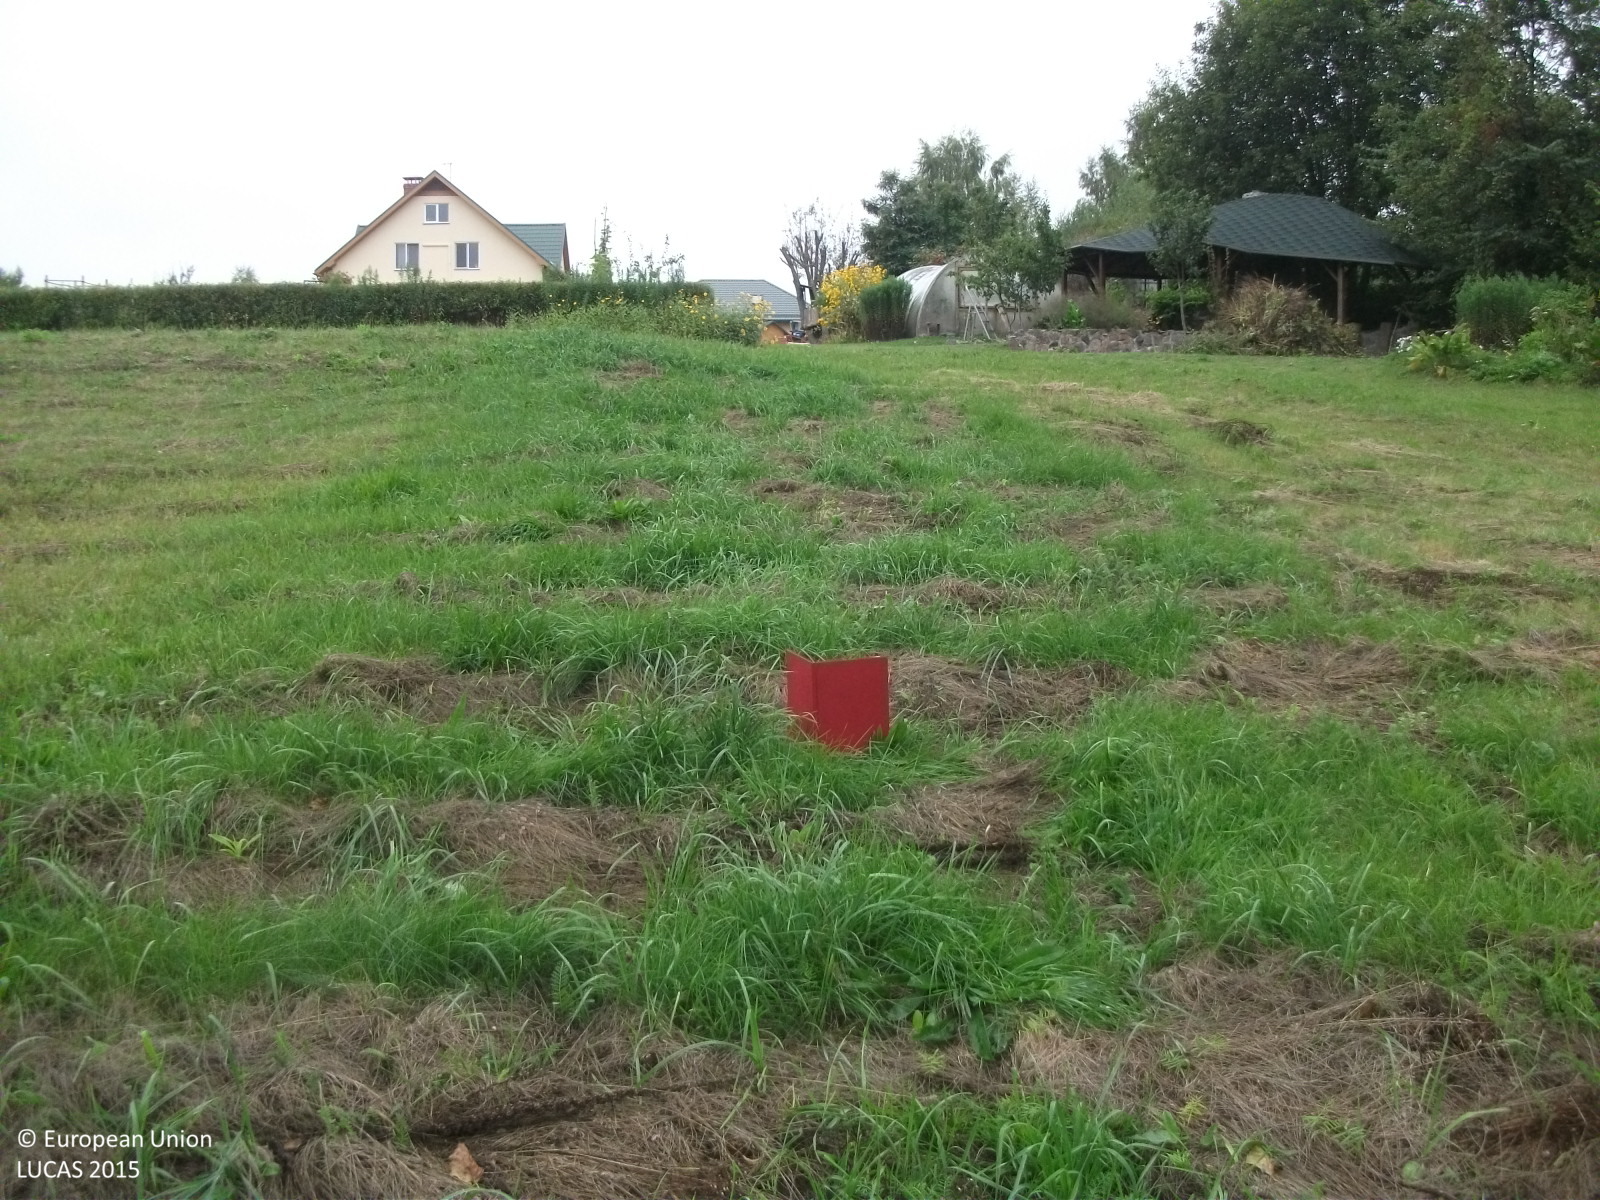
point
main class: Grassland
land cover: Grassland without tree/shrub cover
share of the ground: > 75 %
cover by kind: herbaceous plants 90 %, unconsolidated bare surface 5 %
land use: Residential
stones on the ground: < 10 %
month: September
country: LV
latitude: 57.4969
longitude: 24.6956
